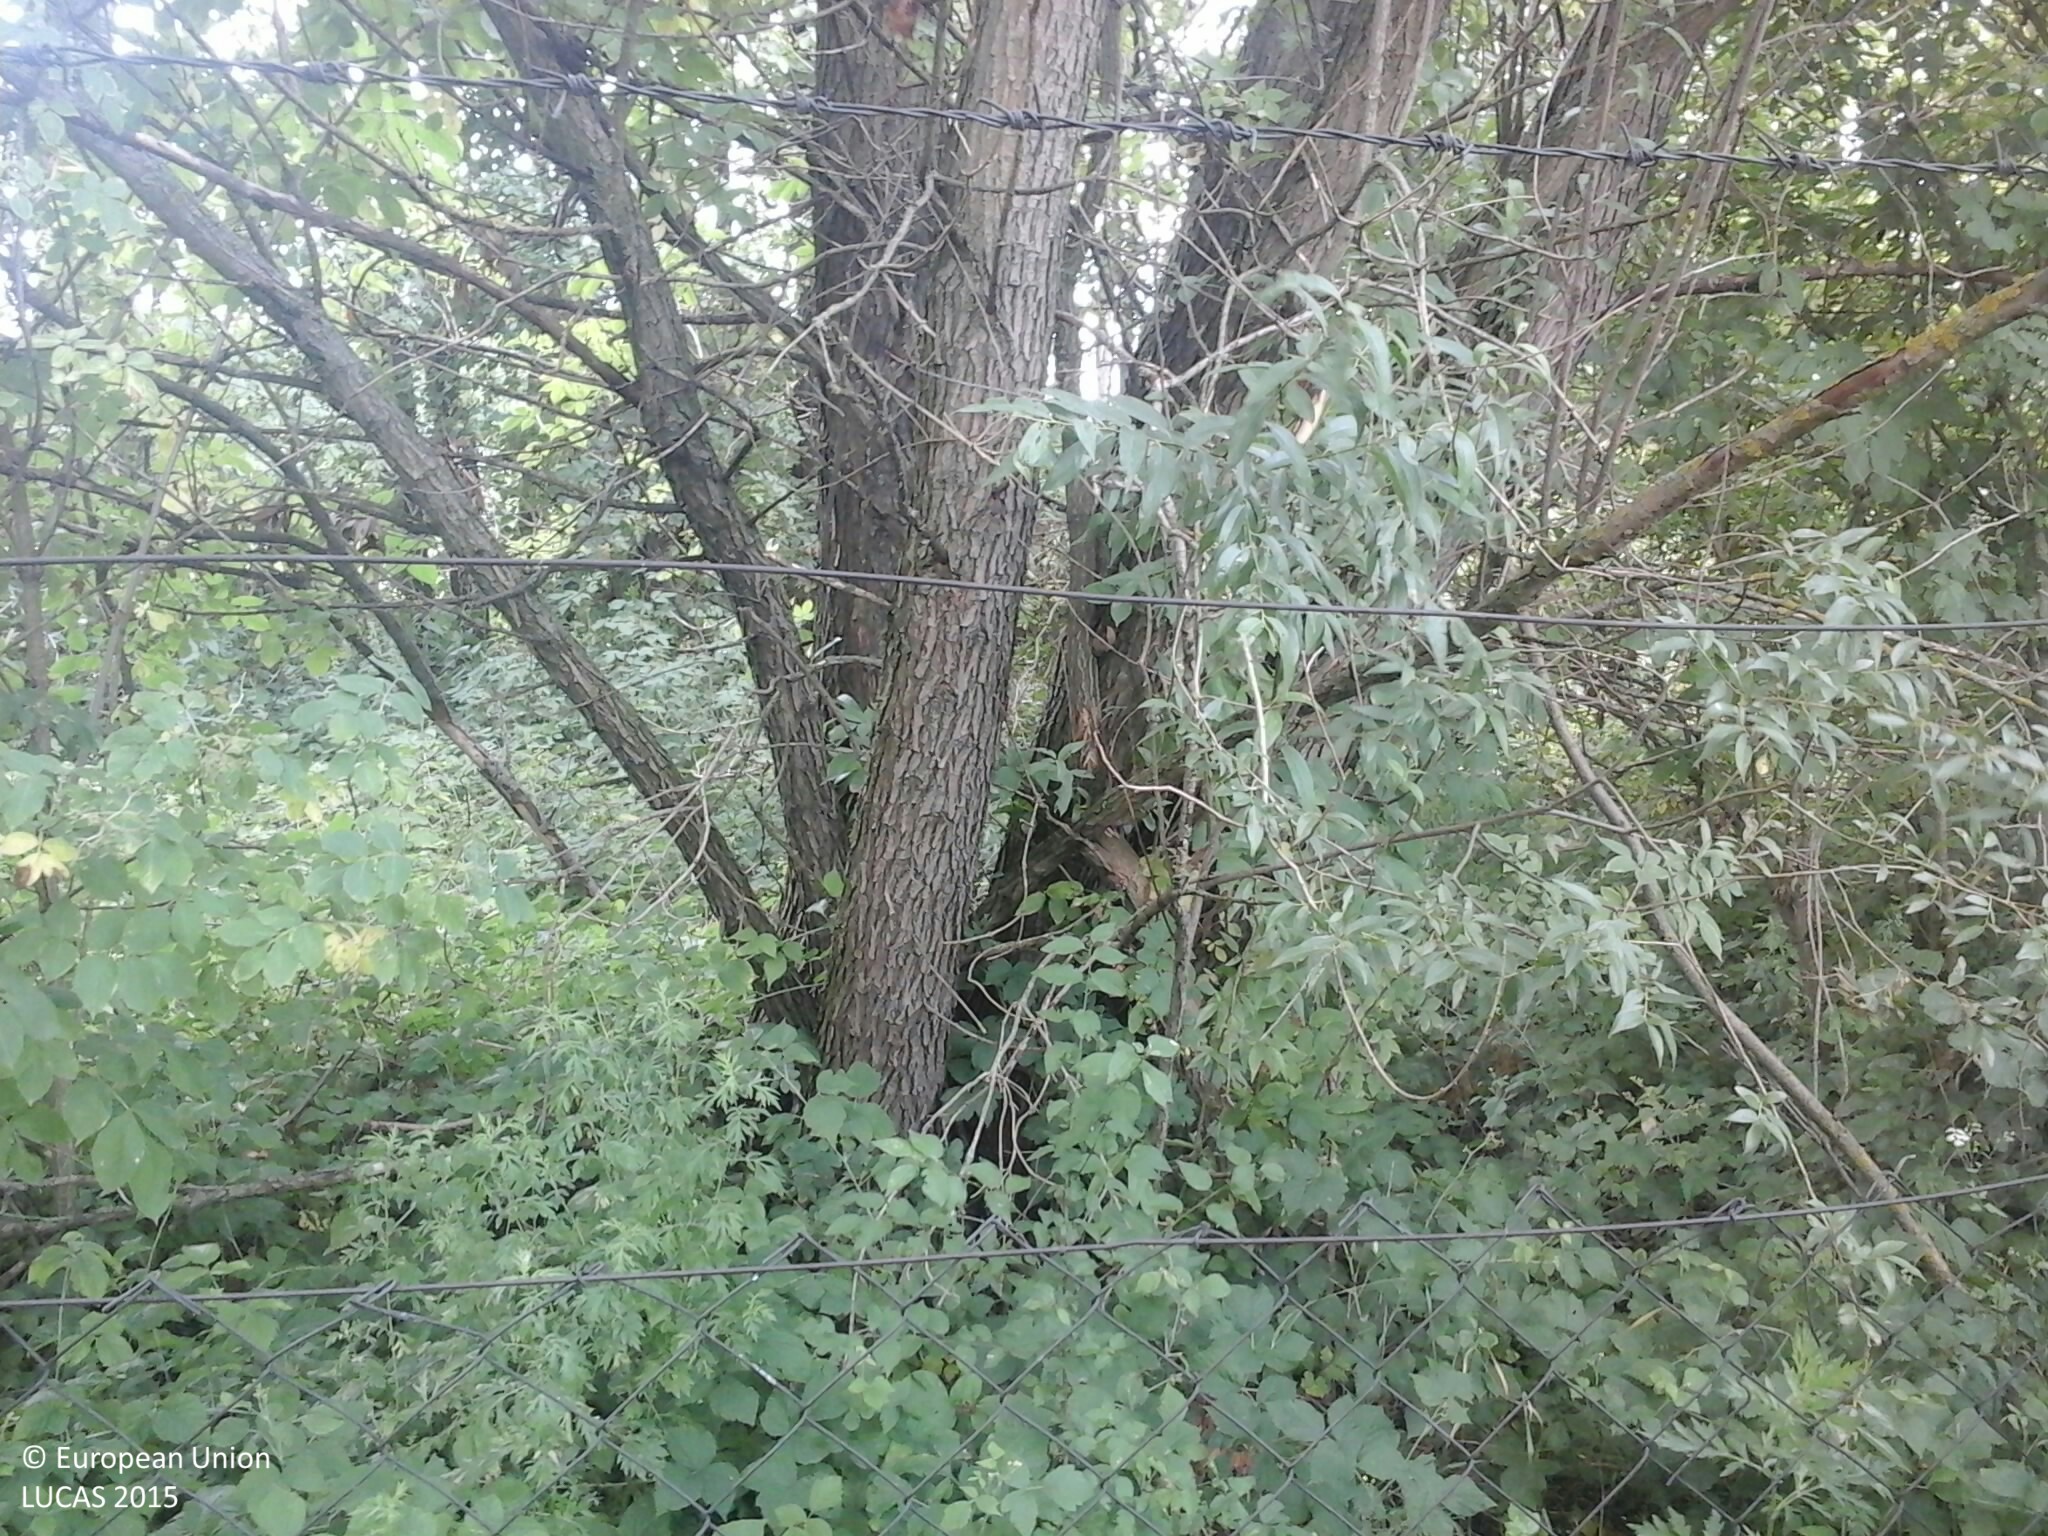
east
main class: Woodland
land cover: Broadleaved woodland
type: exotic forest
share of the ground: > 75 %
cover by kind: broadleaved forest trees 80 %, shrubs 10 %, herbaceous plants 10 %
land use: Abandoned areas
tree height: > 5 m
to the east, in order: Broadleaved woodland; Fences; Broadleaved woodland; Ditches and canals; Broadleaved woodland; Spontaneously vegetated surfaces; Maize; Spontaneously vegetated surfaces; Broadleaved woodland; Ditches and canals; Spontaneously vegetated surfaces; Tracks; Spontaneously vegetated surfaces; Abandoned hedges; Maize; Sunflower
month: July
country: HU
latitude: 47.9022
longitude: 22.2419
